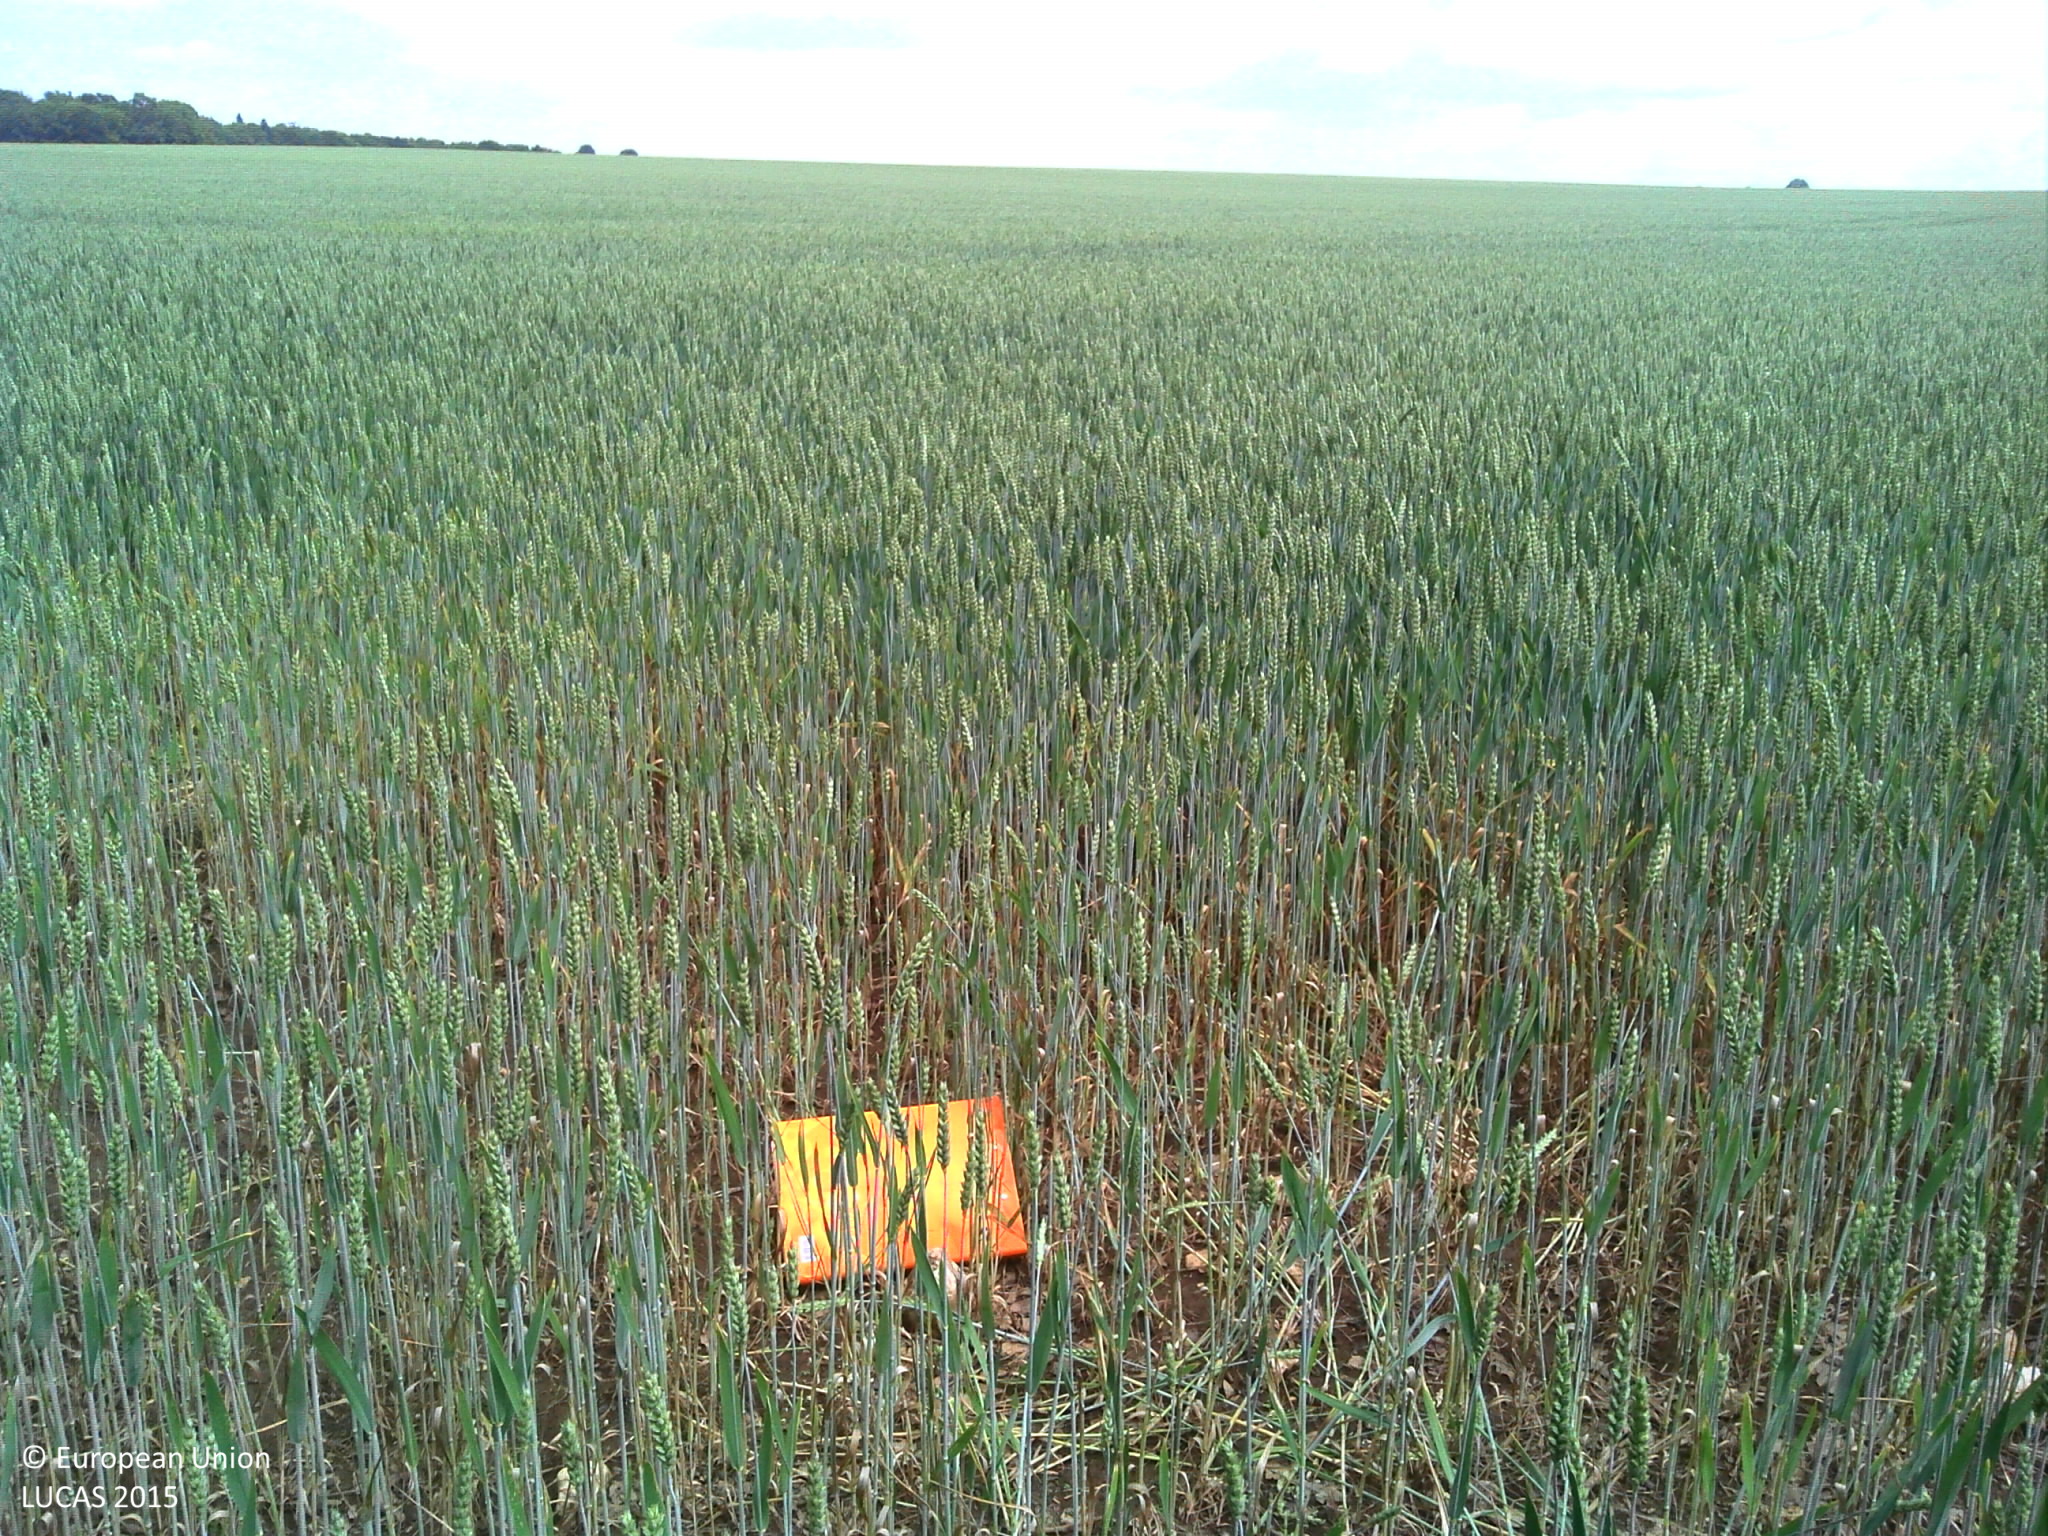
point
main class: Cropland
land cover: Common wheat
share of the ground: > 75 %
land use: Agriculture (excluding fallow land and kitchen gardens)
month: June
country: FR
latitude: 48.2449
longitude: 5.1917
